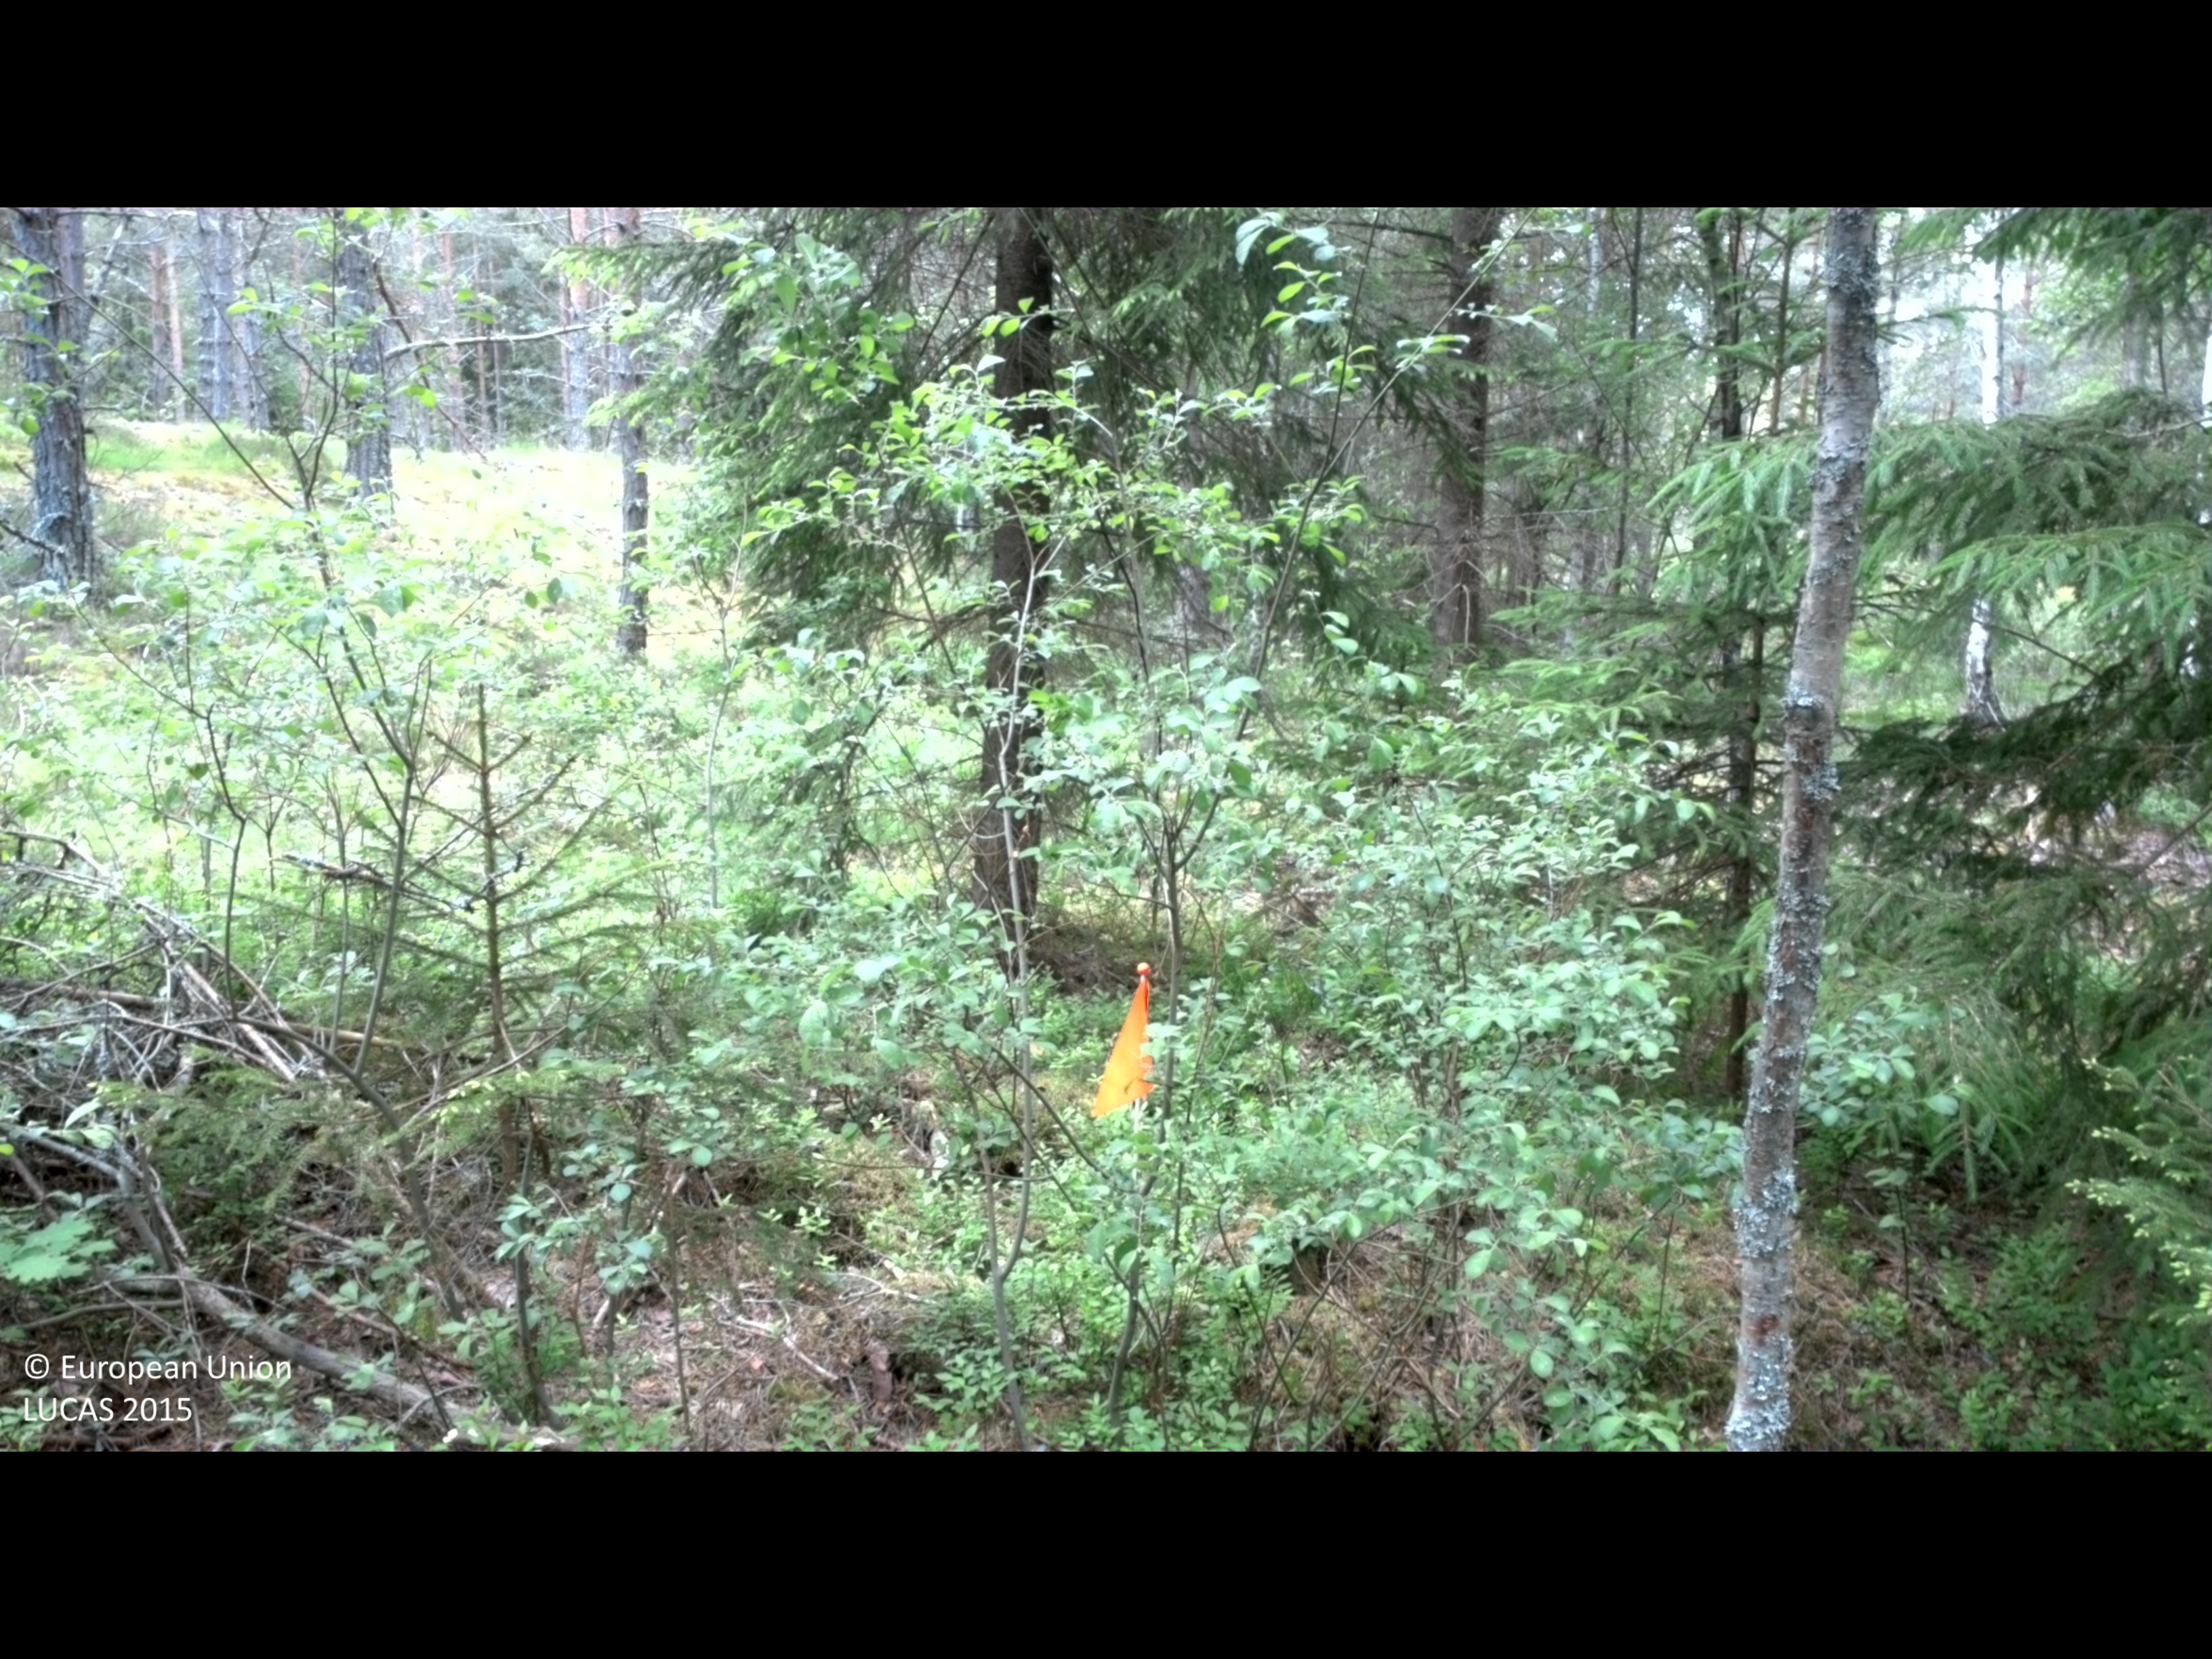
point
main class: Woodland
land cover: Pine dominated mixed woodland
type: boreal forest
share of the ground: > 75 %
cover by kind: coniferous forest trees 45 %, broadleaved forest trees 35 %, shrubs 10 %, lichens and mosses 10 %
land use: Forestry
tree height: > 5 m
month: June
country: SE
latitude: 57.6917
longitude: 16.6926
